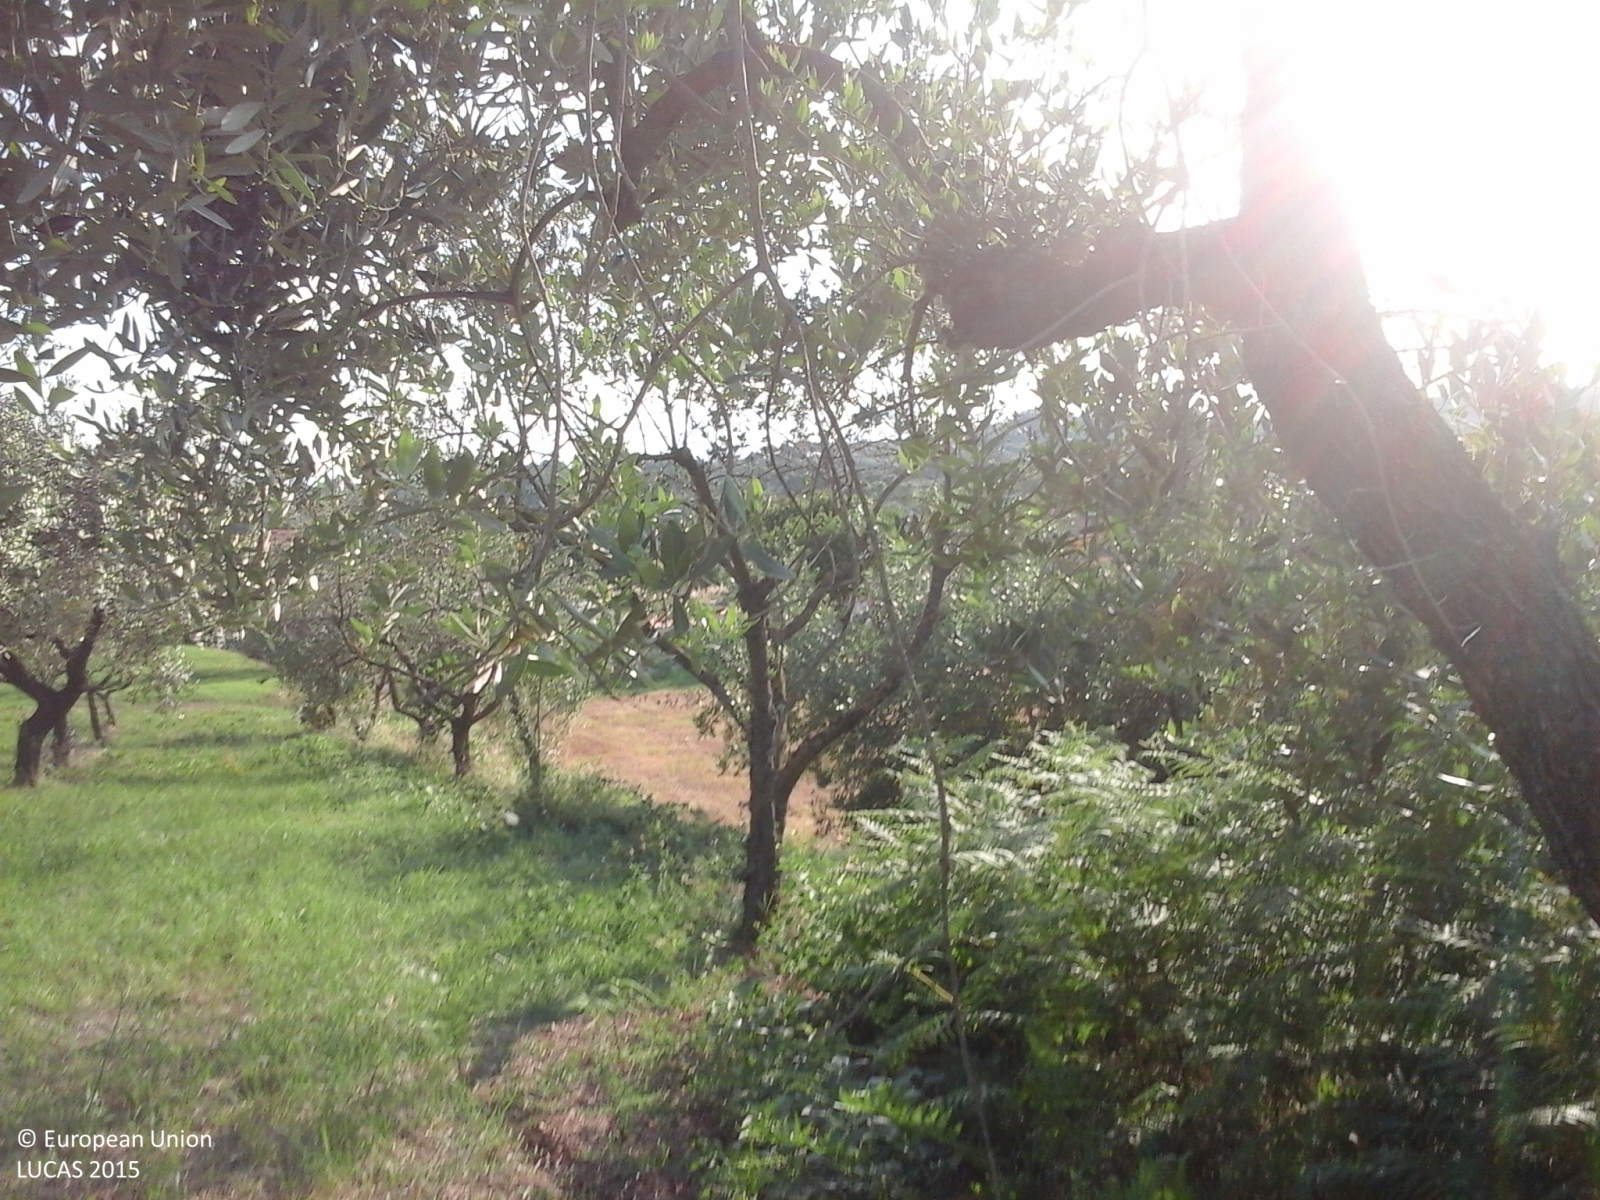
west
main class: Cropland
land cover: Olive groves
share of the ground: 25 - 50 %
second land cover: Grassland without tree/shrub cover
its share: > 75 %
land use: Agriculture (excluding fallow land and kitchen gardens)
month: June
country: IT
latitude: 41.8102
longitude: 13.1301
